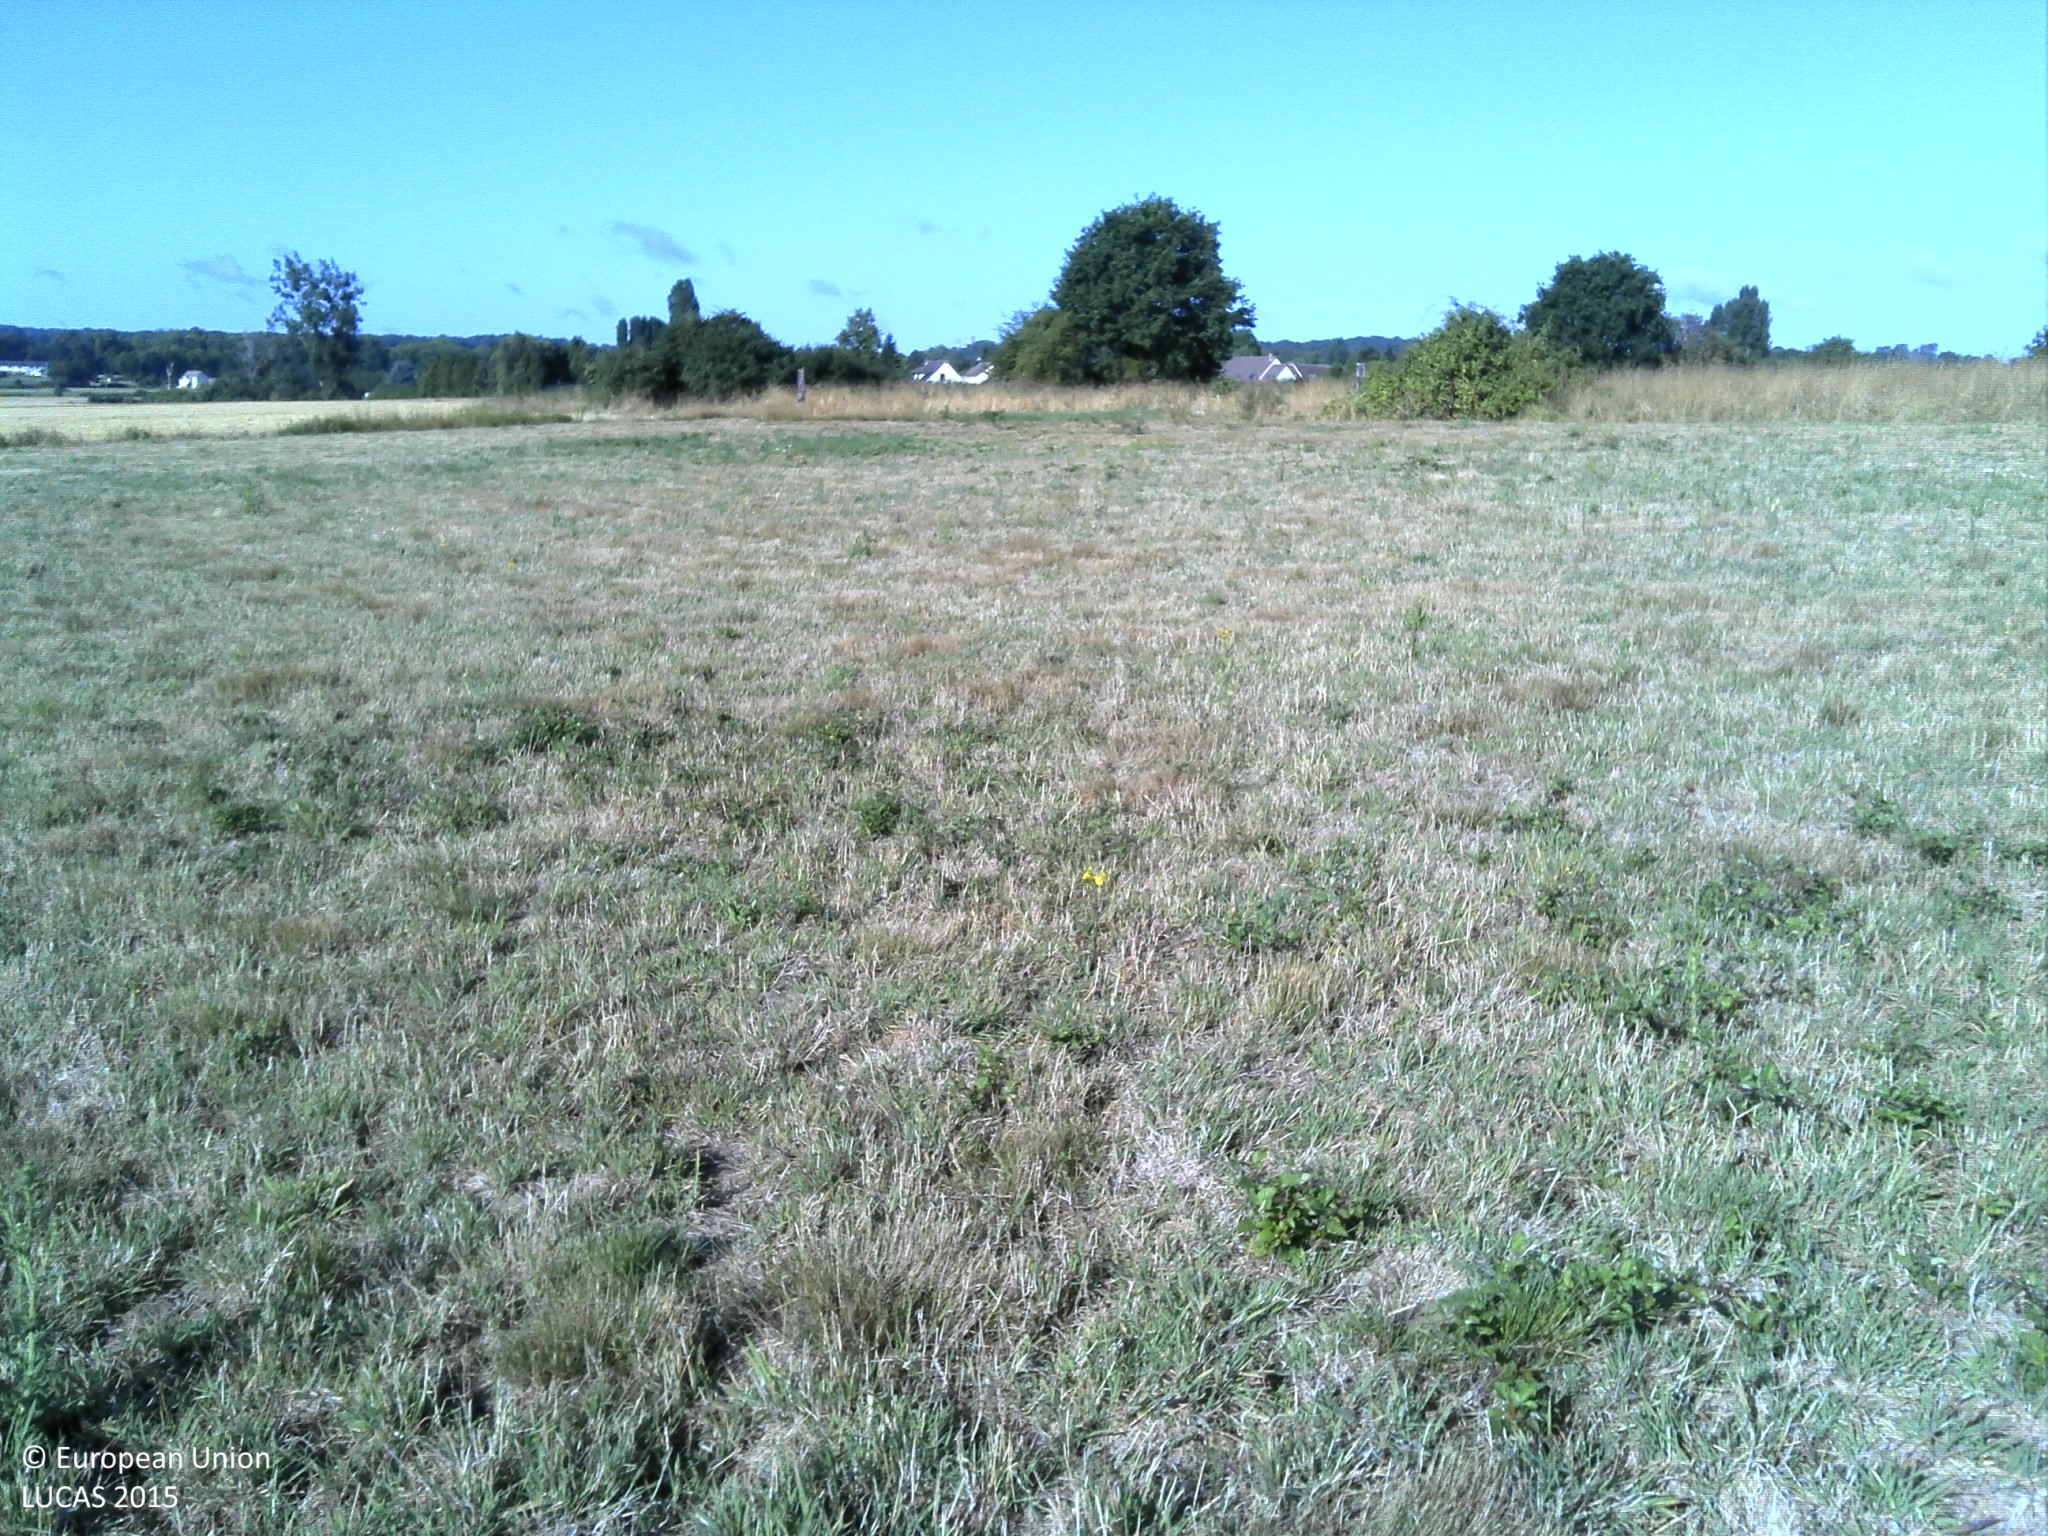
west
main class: Grassland
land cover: Grassland without tree/shrub cover
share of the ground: > 75 %
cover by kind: herbaceous plants 100 %
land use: Agriculture (excluding fallow land and kitchen gardens)
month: July
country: FR
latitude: 48.7881
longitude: 1.8318
